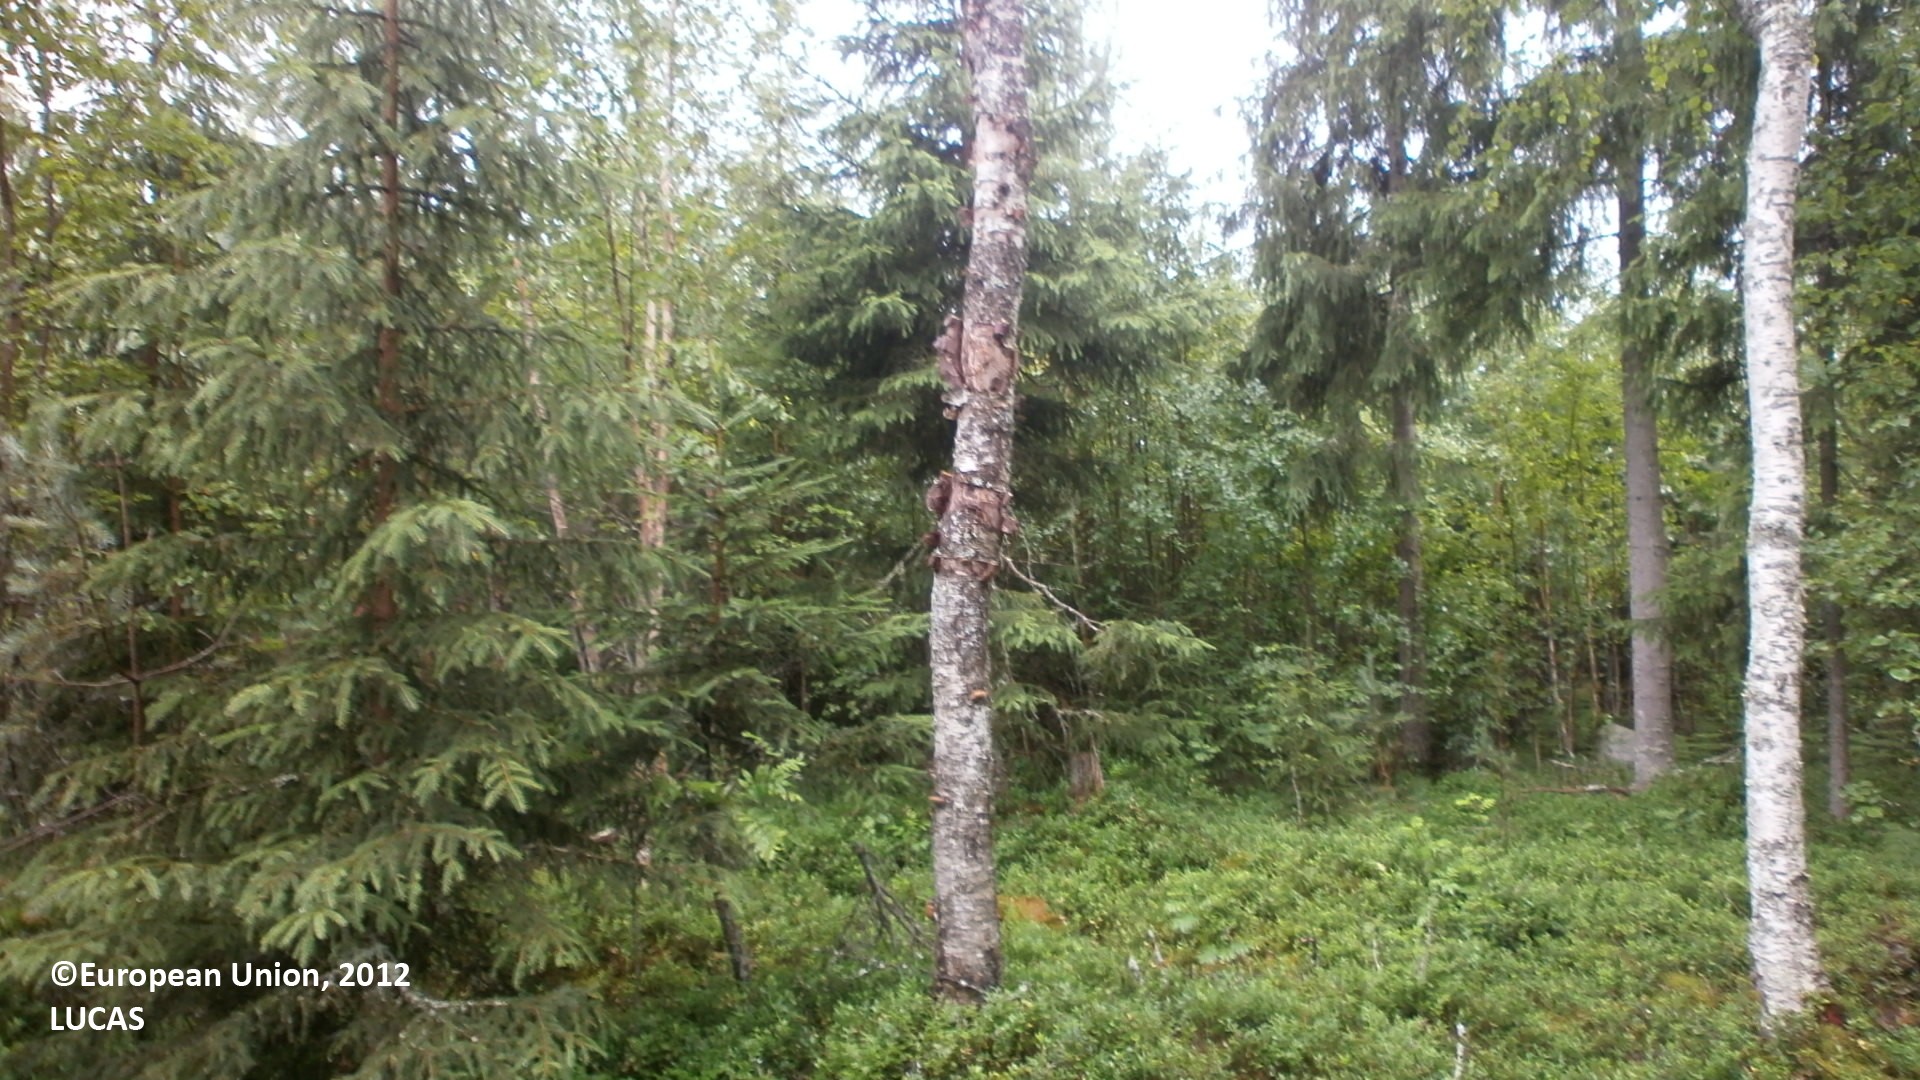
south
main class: Woodland
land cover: Spruce dominated mixed woodland
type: boreal forest
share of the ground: > 75 %
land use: Forestry
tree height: > 5 m
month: July
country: FI
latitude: 64.0522
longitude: 23.7646
